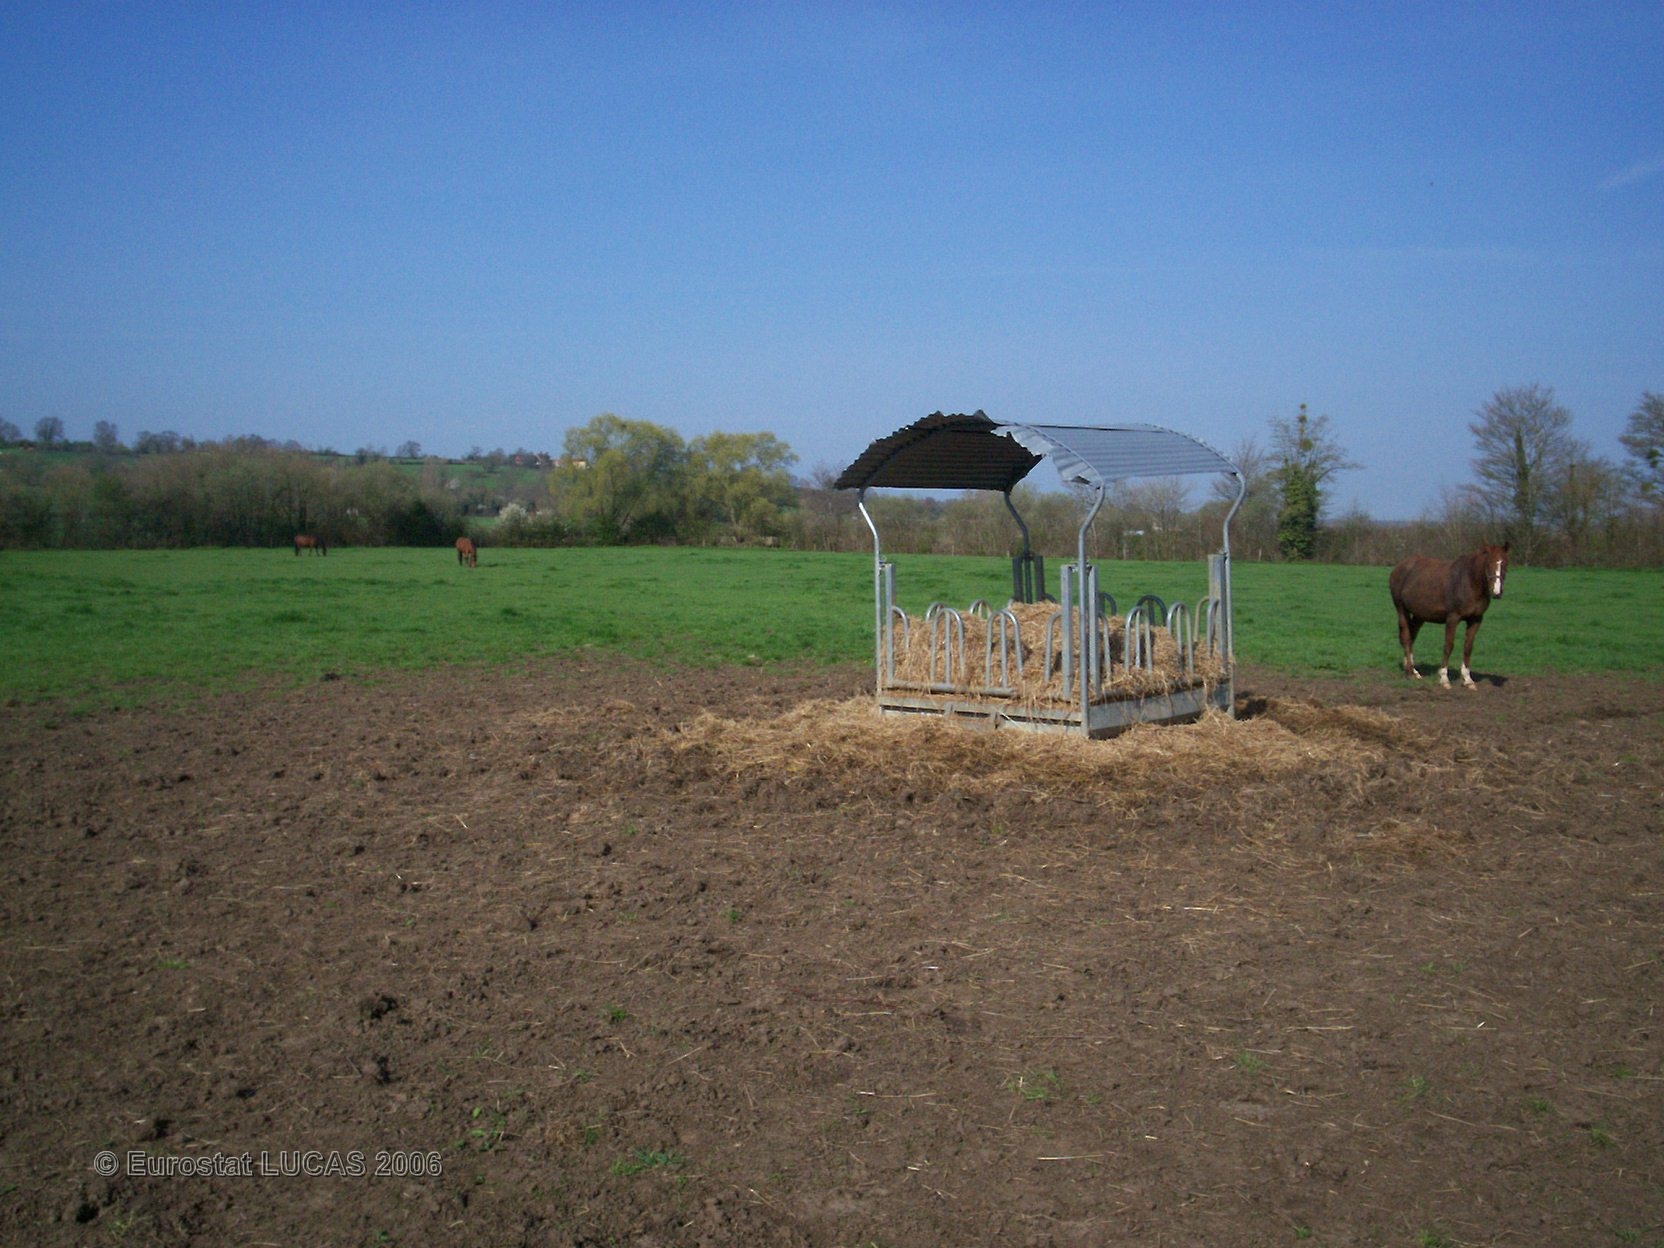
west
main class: Grassland
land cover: Grassland without tree/shrub cover
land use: Agriculture (excluding fallow land and kitchen gardens)
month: April
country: FR
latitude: 49.0898
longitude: -0.0136
